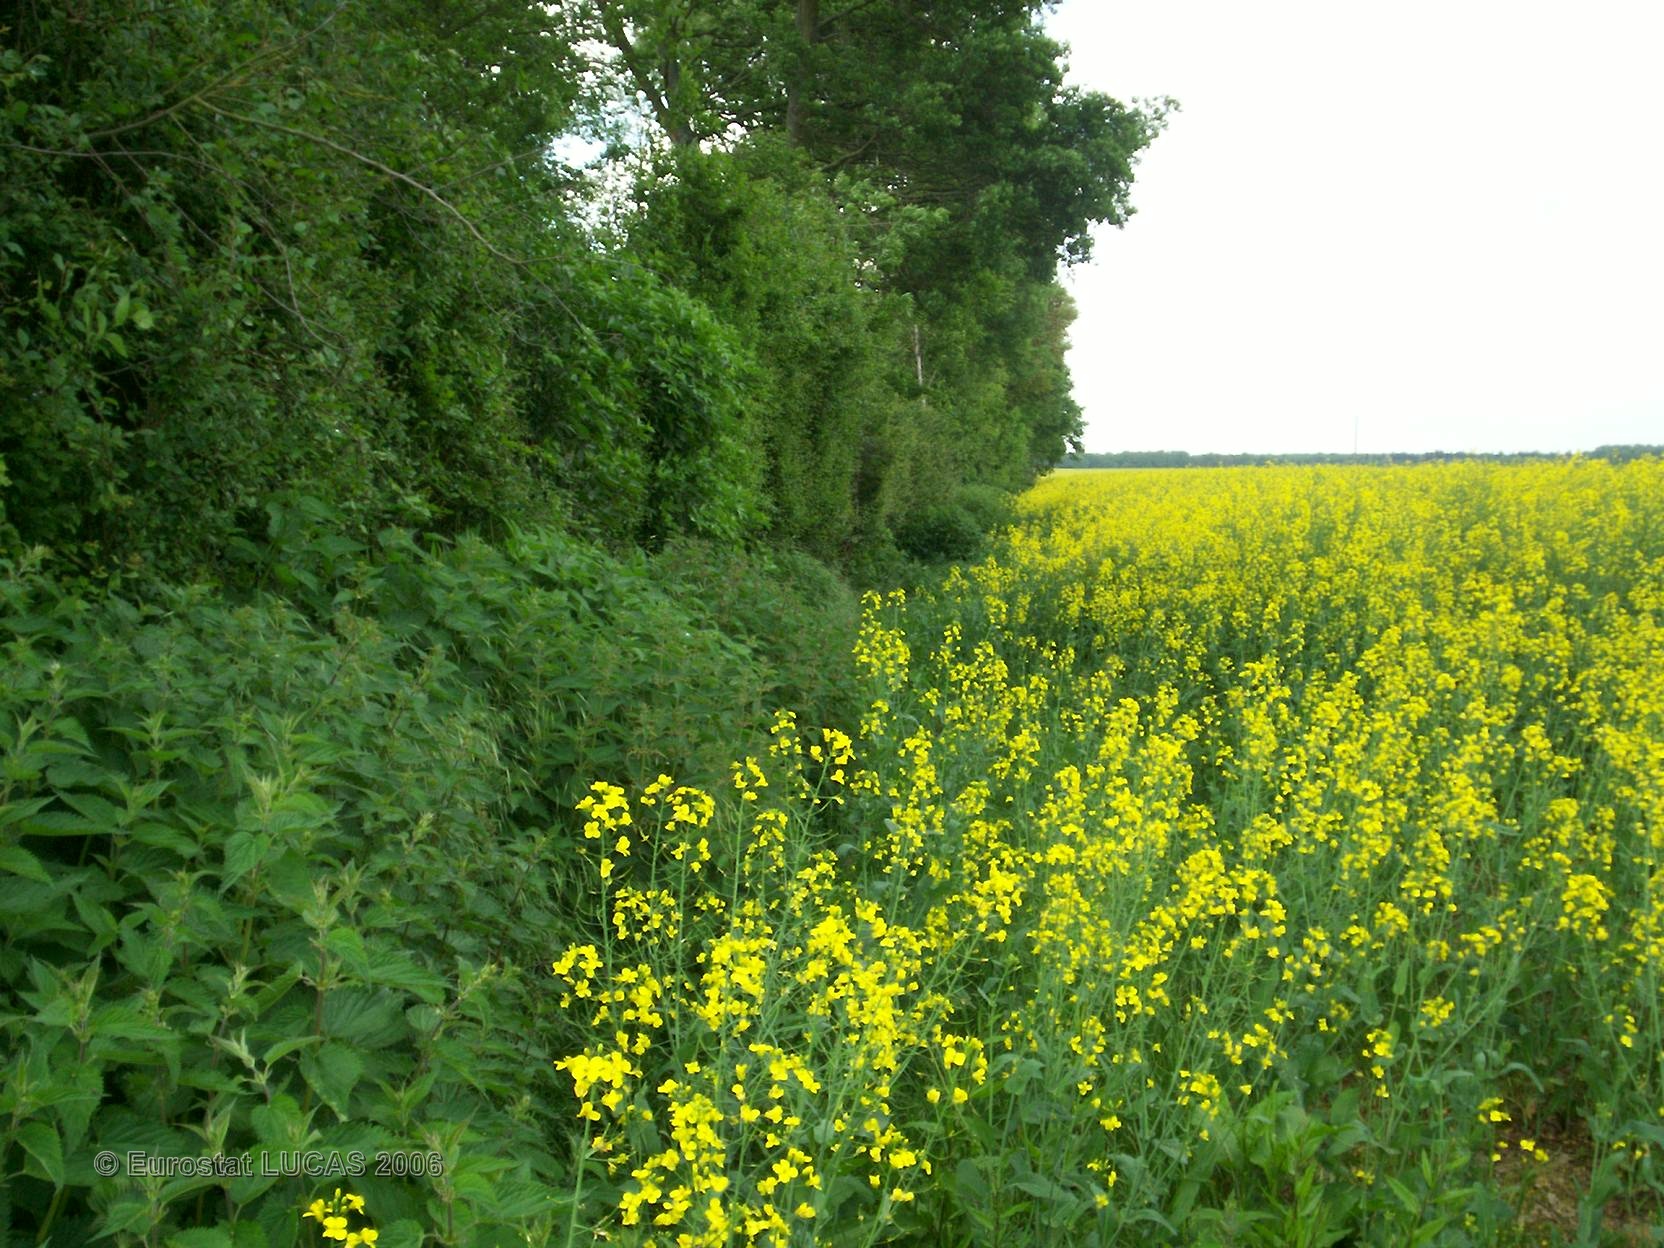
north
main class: Cropland
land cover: Rape and turnip rape
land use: Agriculture (excluding fallow land and kitchen gardens)
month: May
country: FR
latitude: 48.7625
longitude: 2.7665
